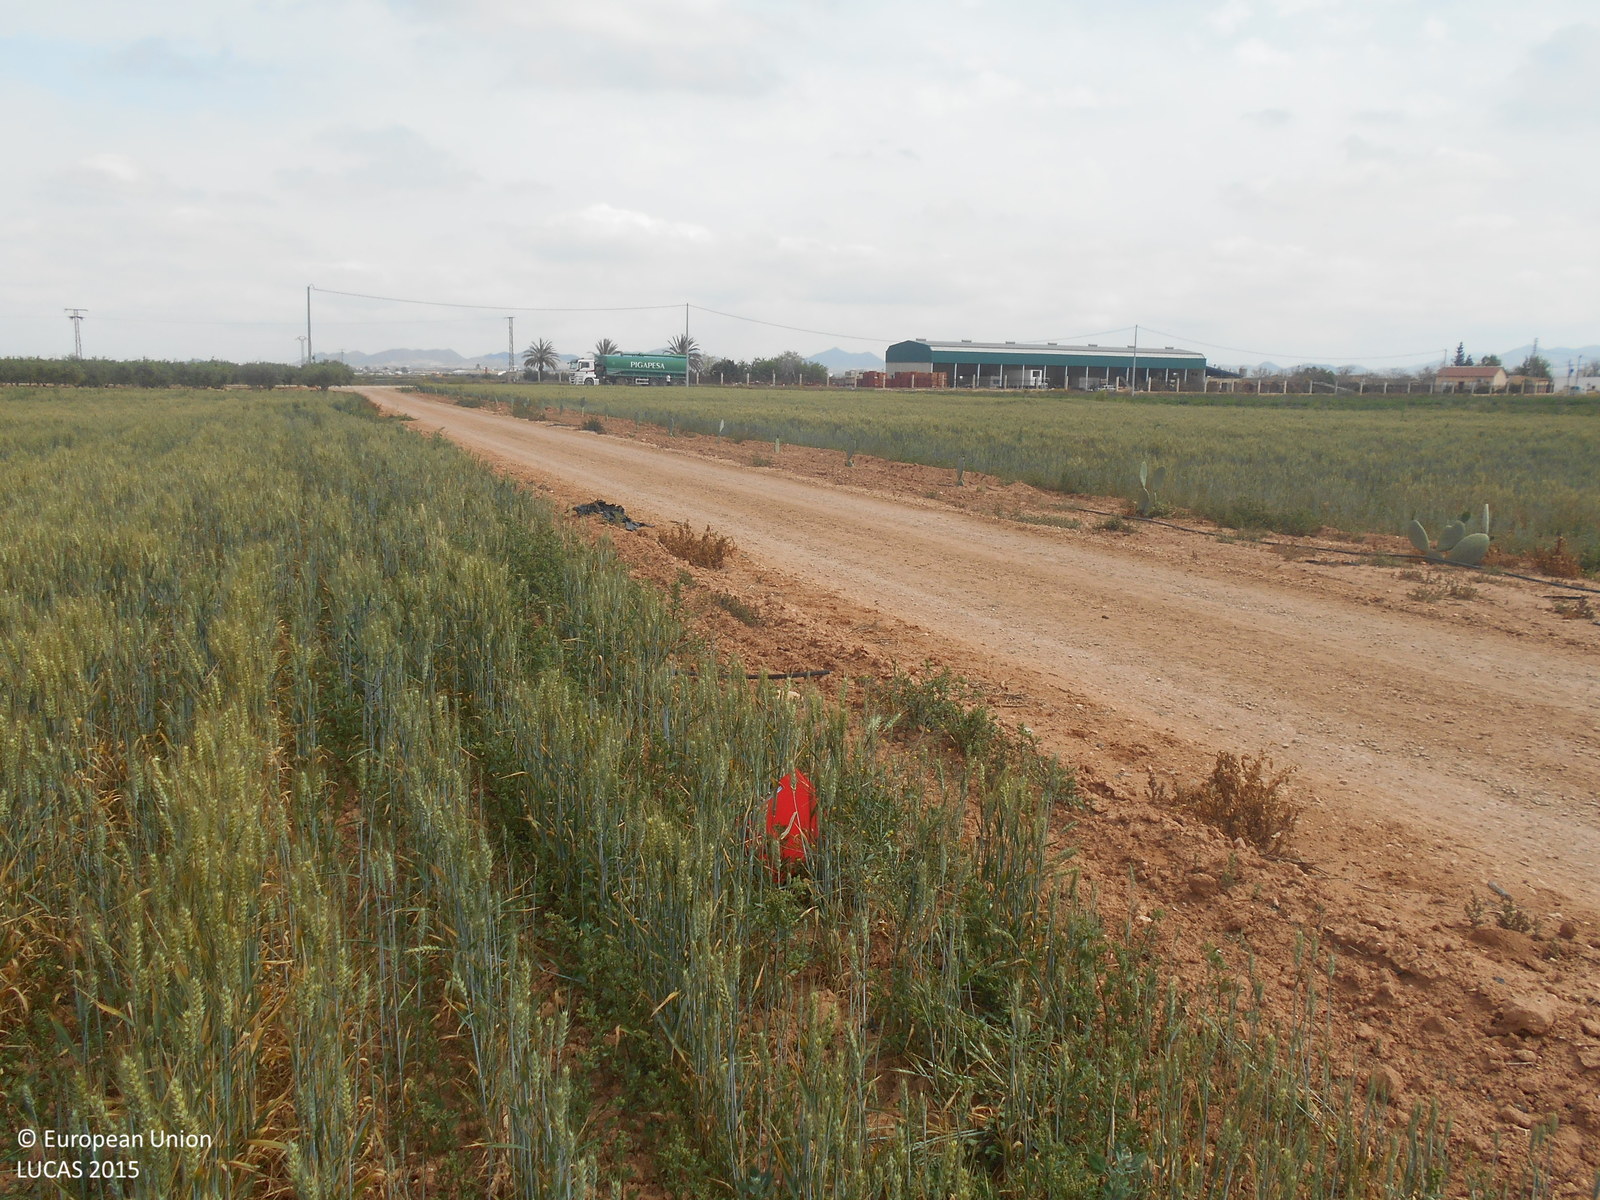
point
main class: Cropland
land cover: Durum wheat
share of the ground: > 75 %
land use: Agriculture (excluding fallow land and kitchen gardens)
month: April
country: ES
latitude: 37.7211
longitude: -1.2239
